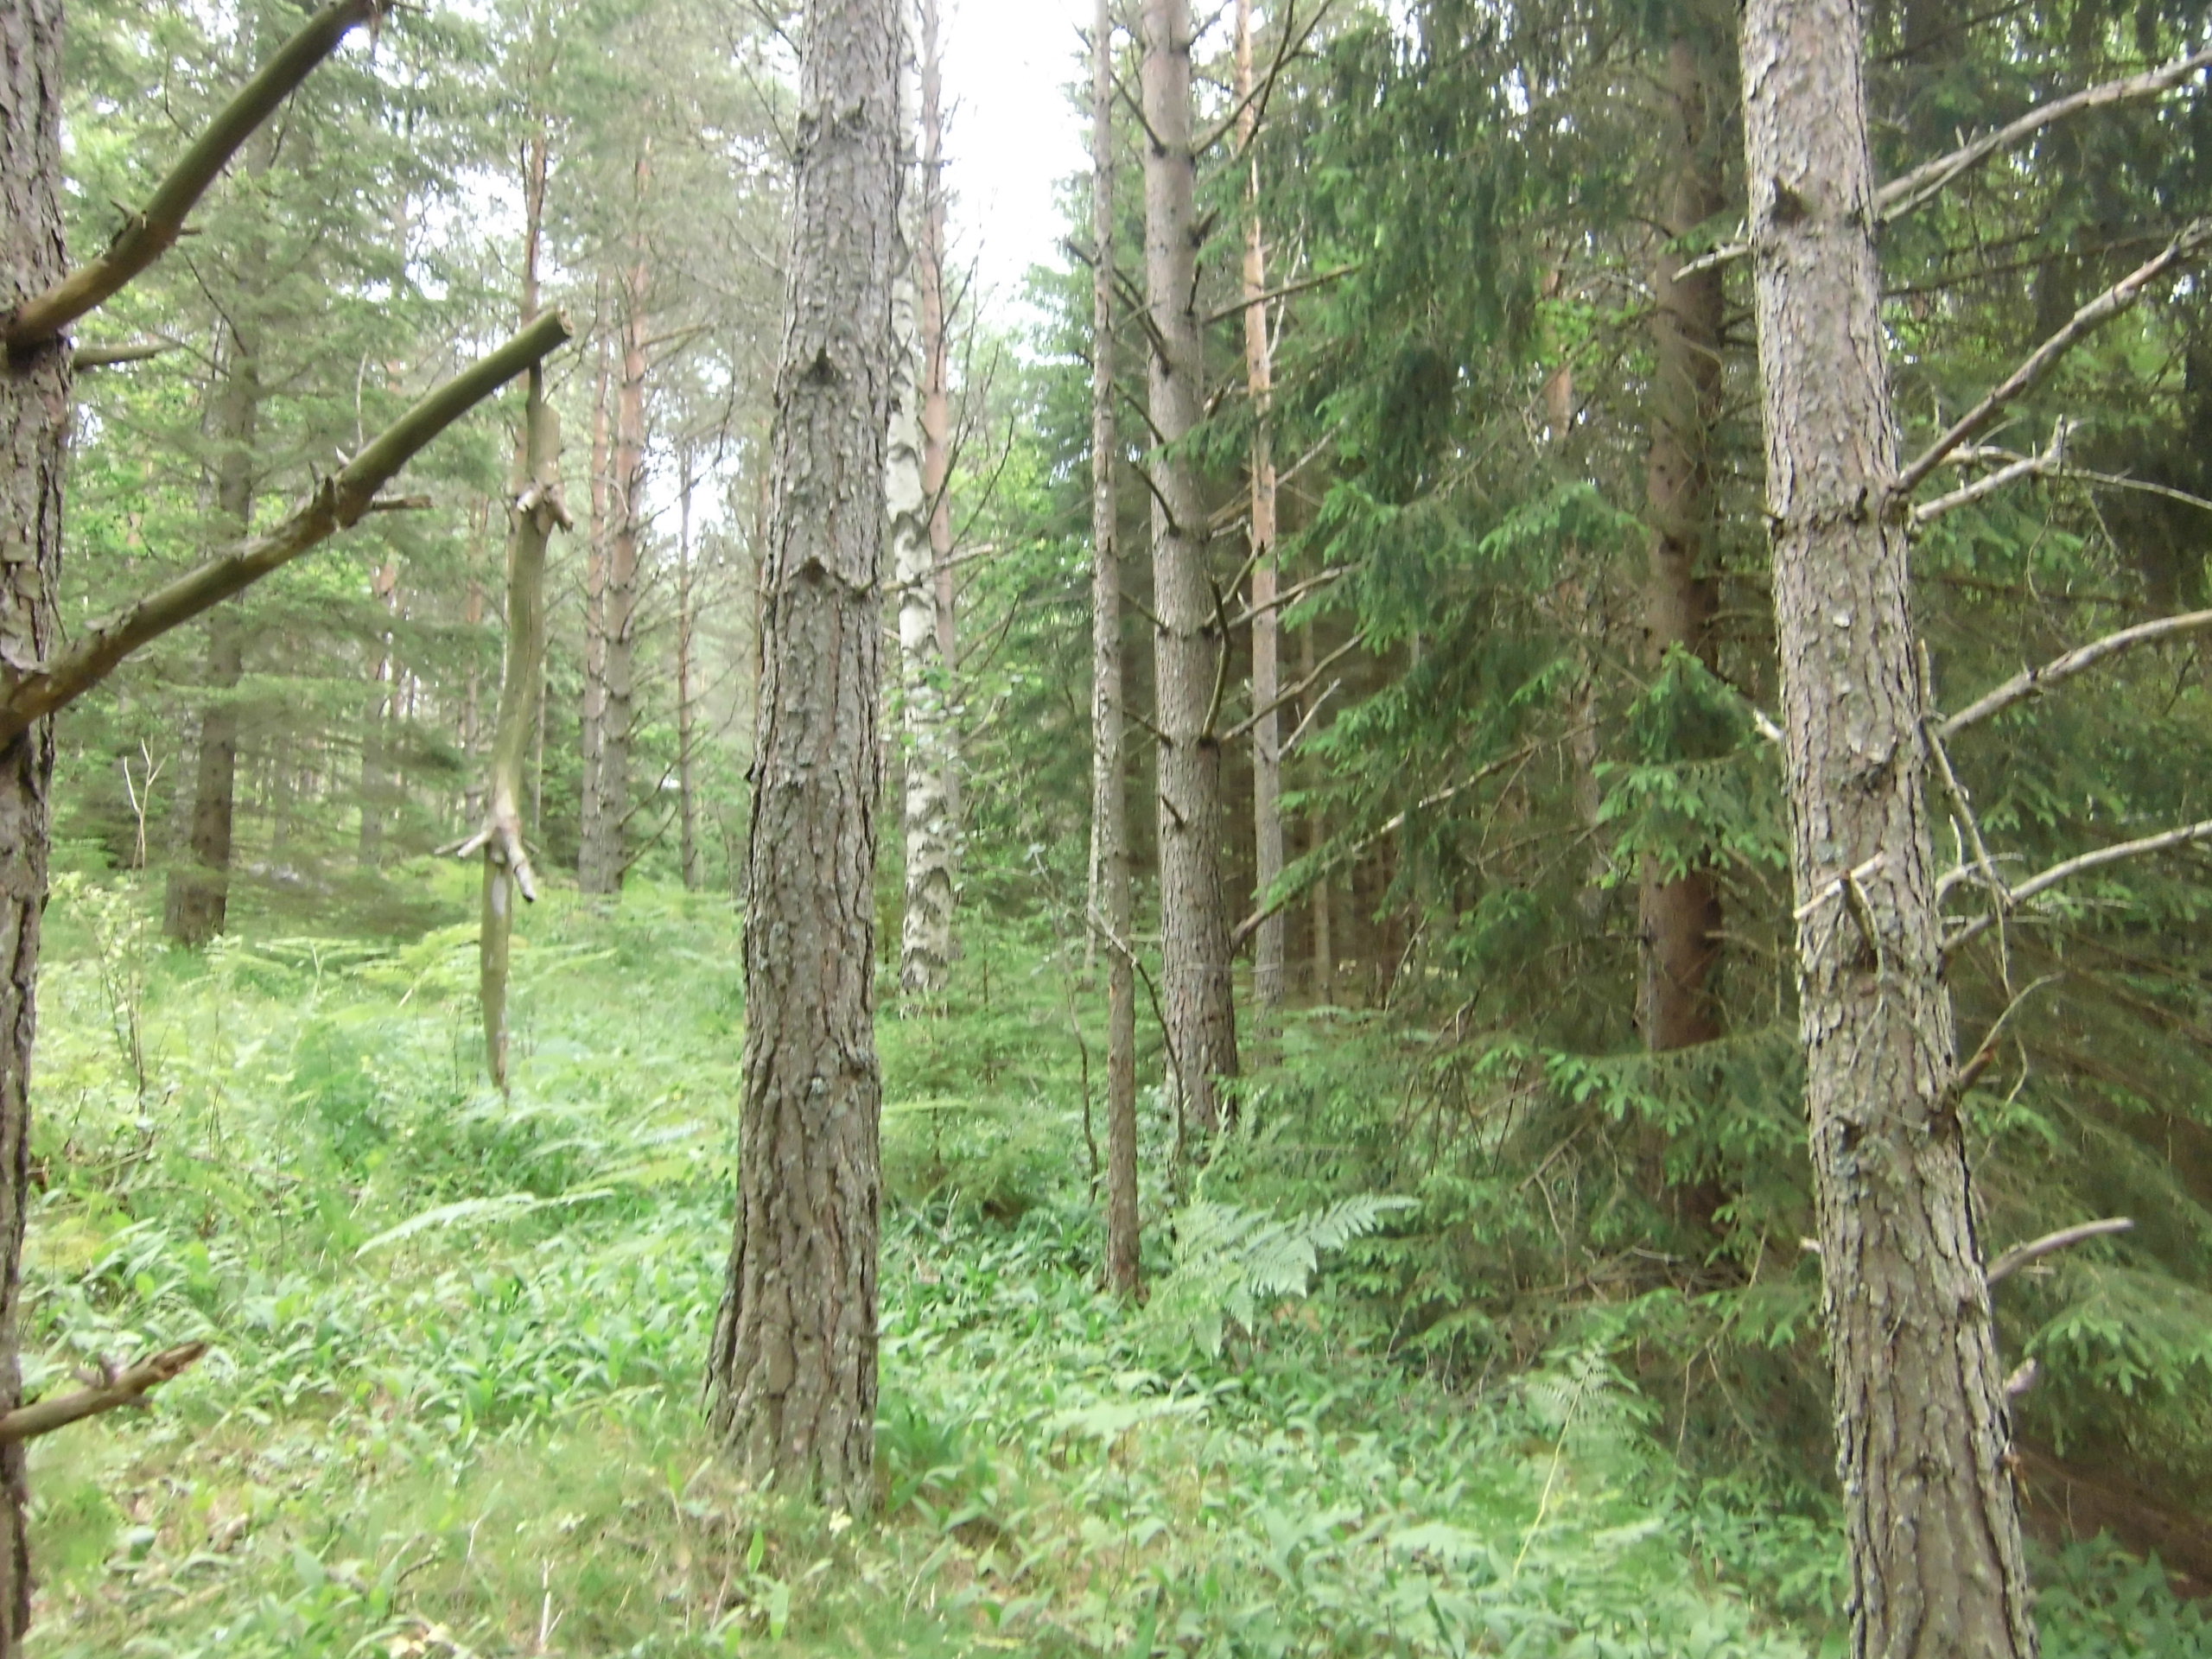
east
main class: Woodland
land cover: Pine dominated coniferous woodland
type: boreal forest
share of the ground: 50 - 75 %
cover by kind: coniferous forest trees 55 %, herbaceous plants 30 %, broadleaved forest trees 5 %, shrubs 5 %, lichens and mosses 5 %
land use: Forestry
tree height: > 5 m
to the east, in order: Pine dominated coniferous woodland; Tracks; Pine dominated coniferous woodland; Pine dominated mixed woodland; Broadleaved woodland
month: July
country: SE
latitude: 57.3721
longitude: 14.9351
